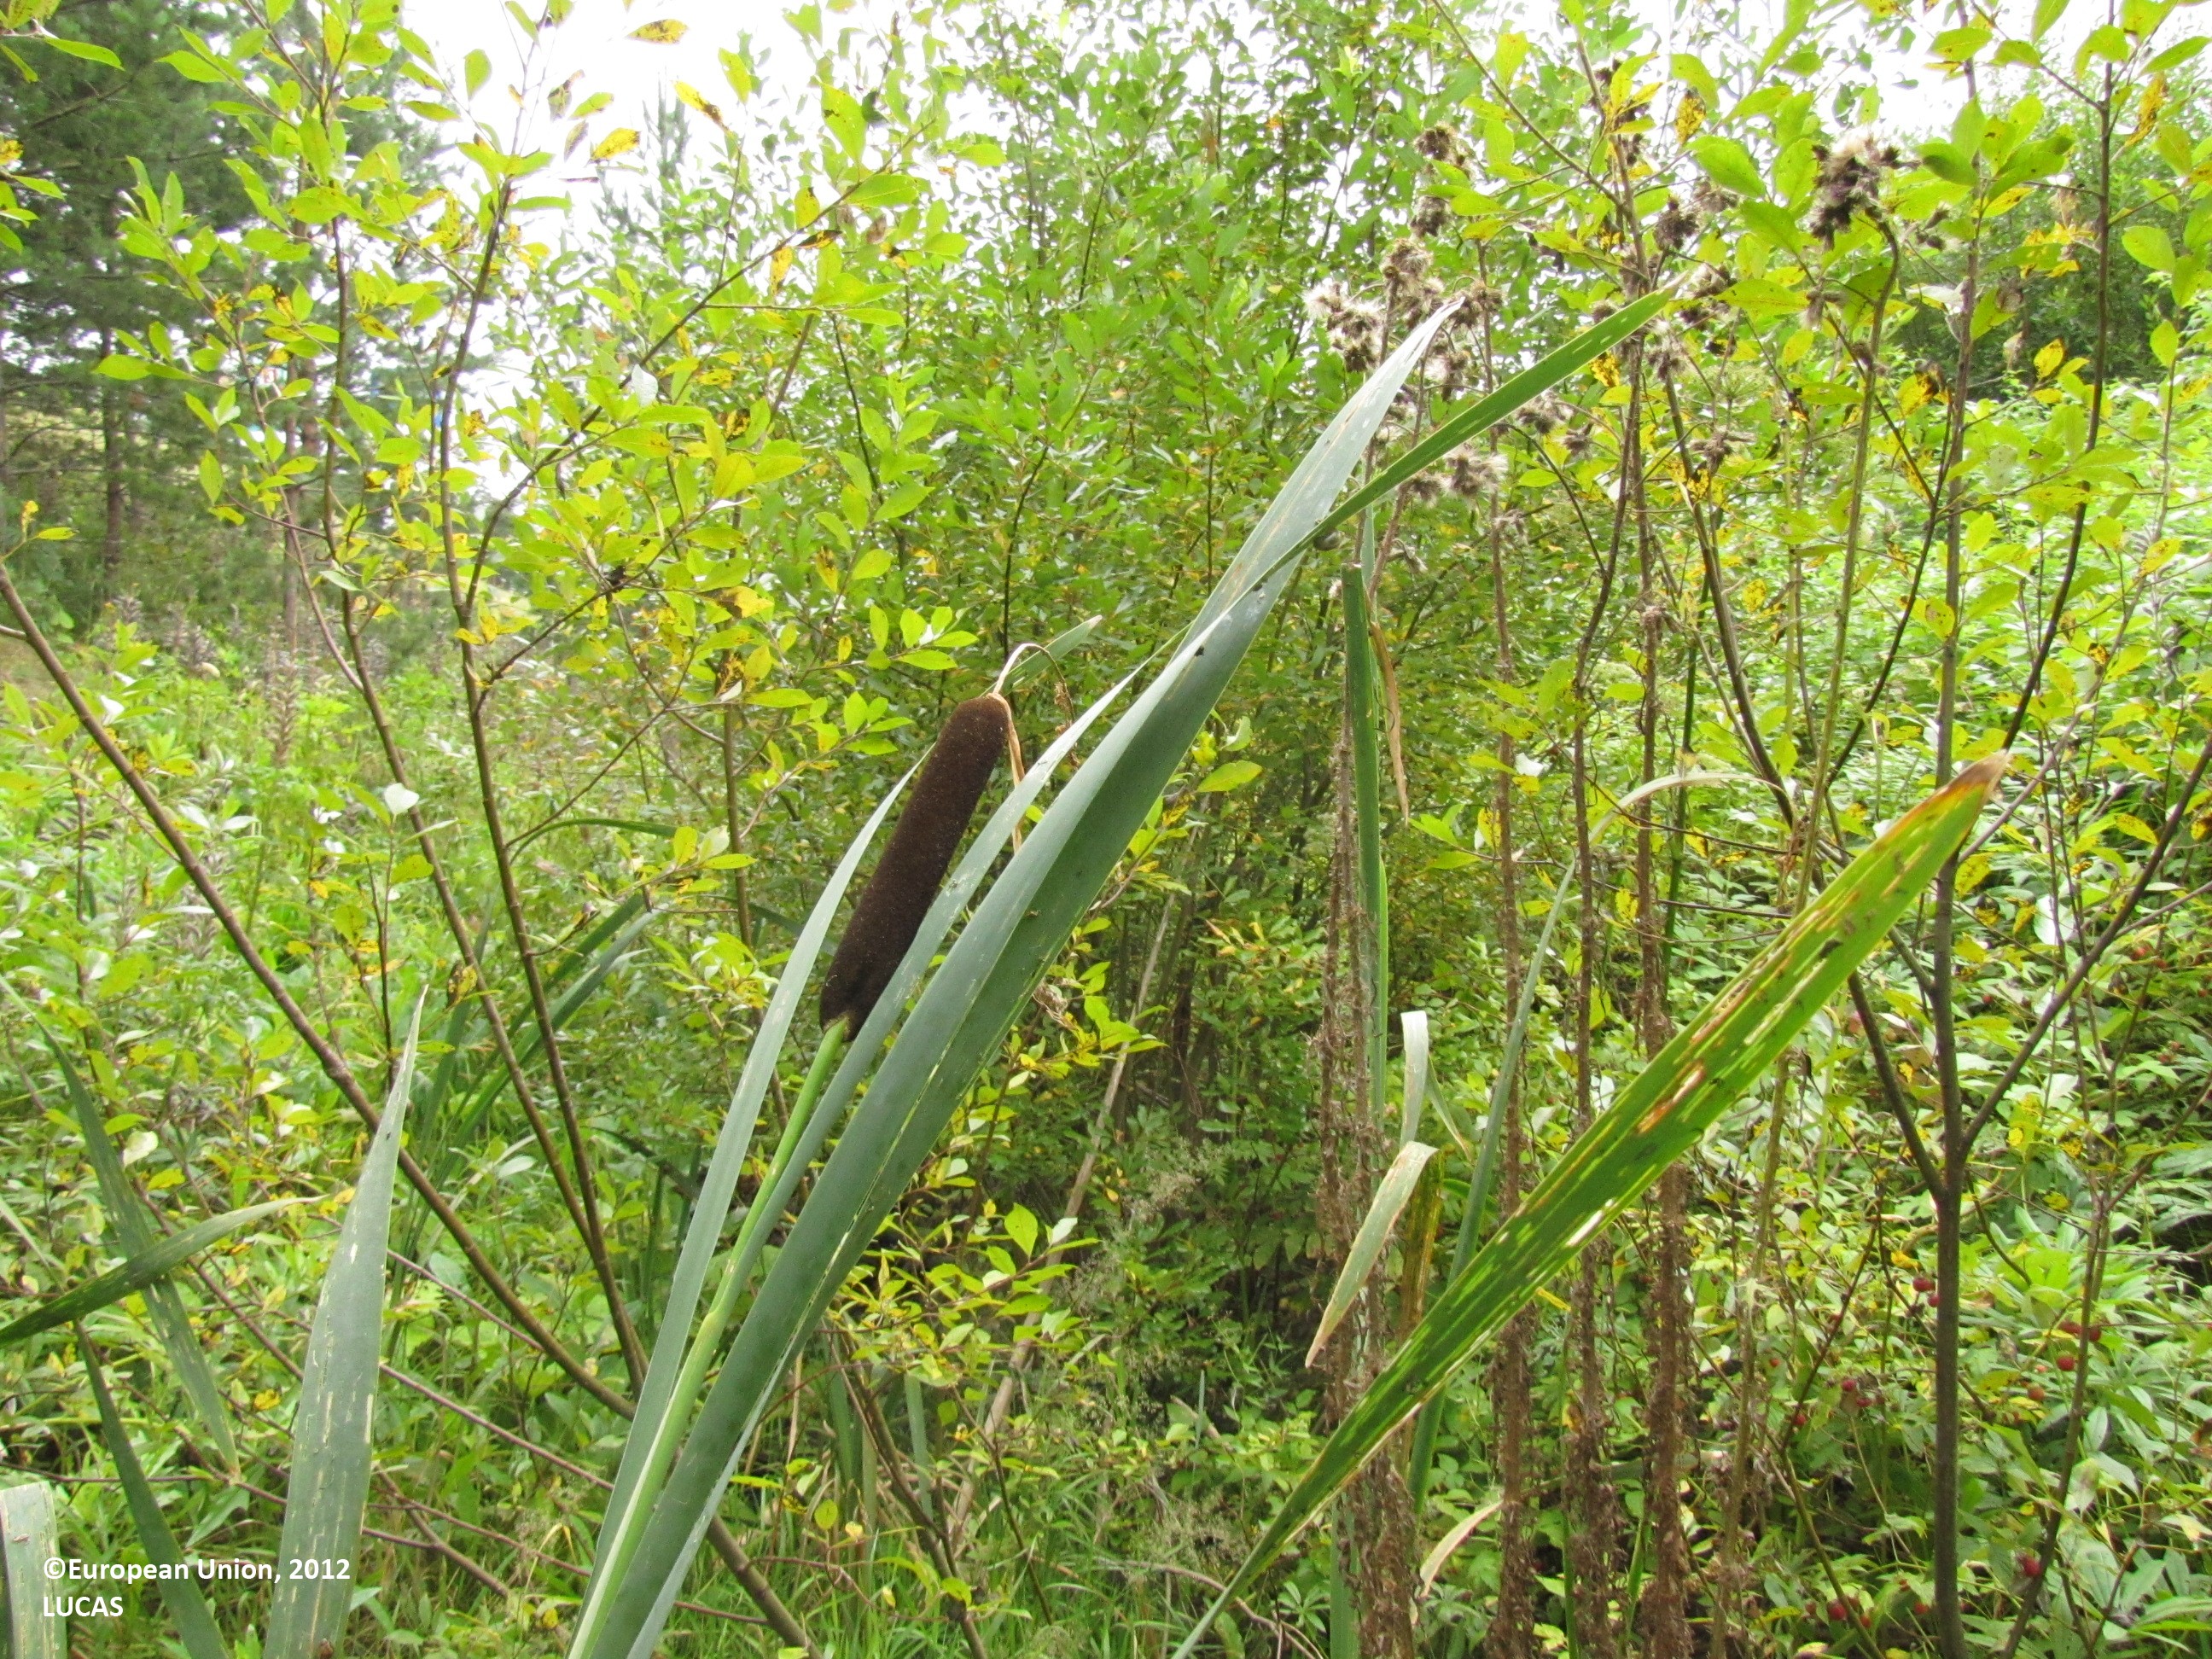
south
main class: Shrubland
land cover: Shrubland with sparse tree cover
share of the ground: > 75 %
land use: Road transport
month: August
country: FI
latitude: 61.5538
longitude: 23.5736
